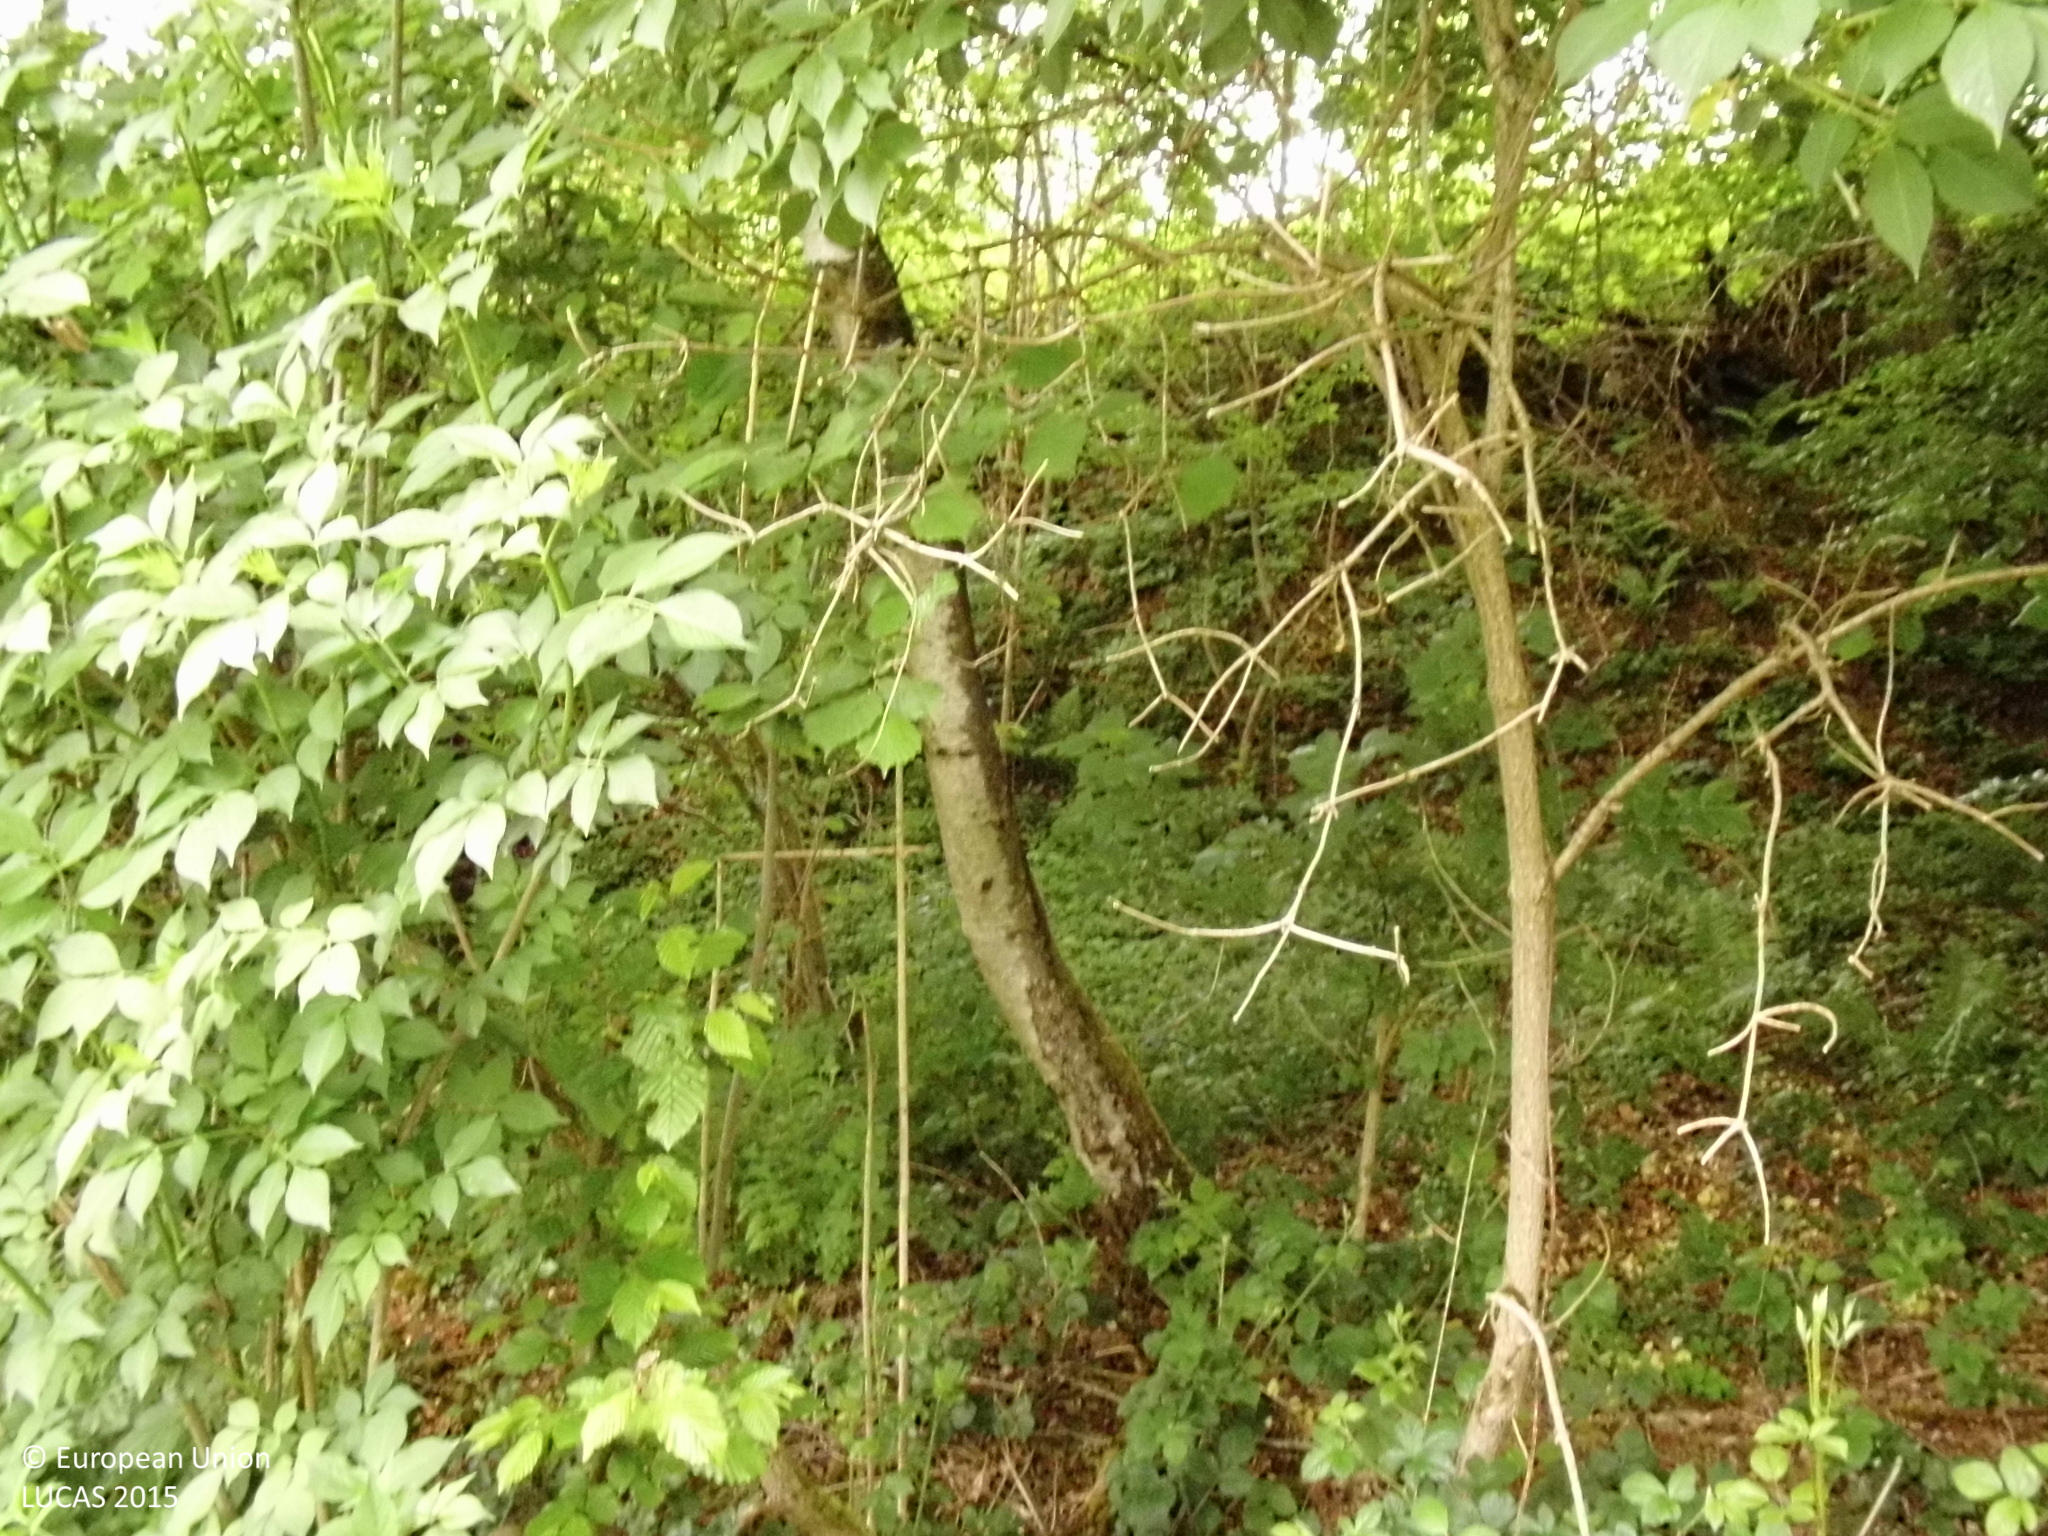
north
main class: Woodland
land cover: Broadleaved woodland
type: mesophytic deciduous forest
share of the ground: > 75 %
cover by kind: broadleaved forest trees 100 %
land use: Forestry
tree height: > 5 m
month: May
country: DE
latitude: 50.8761
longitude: 7.4847
